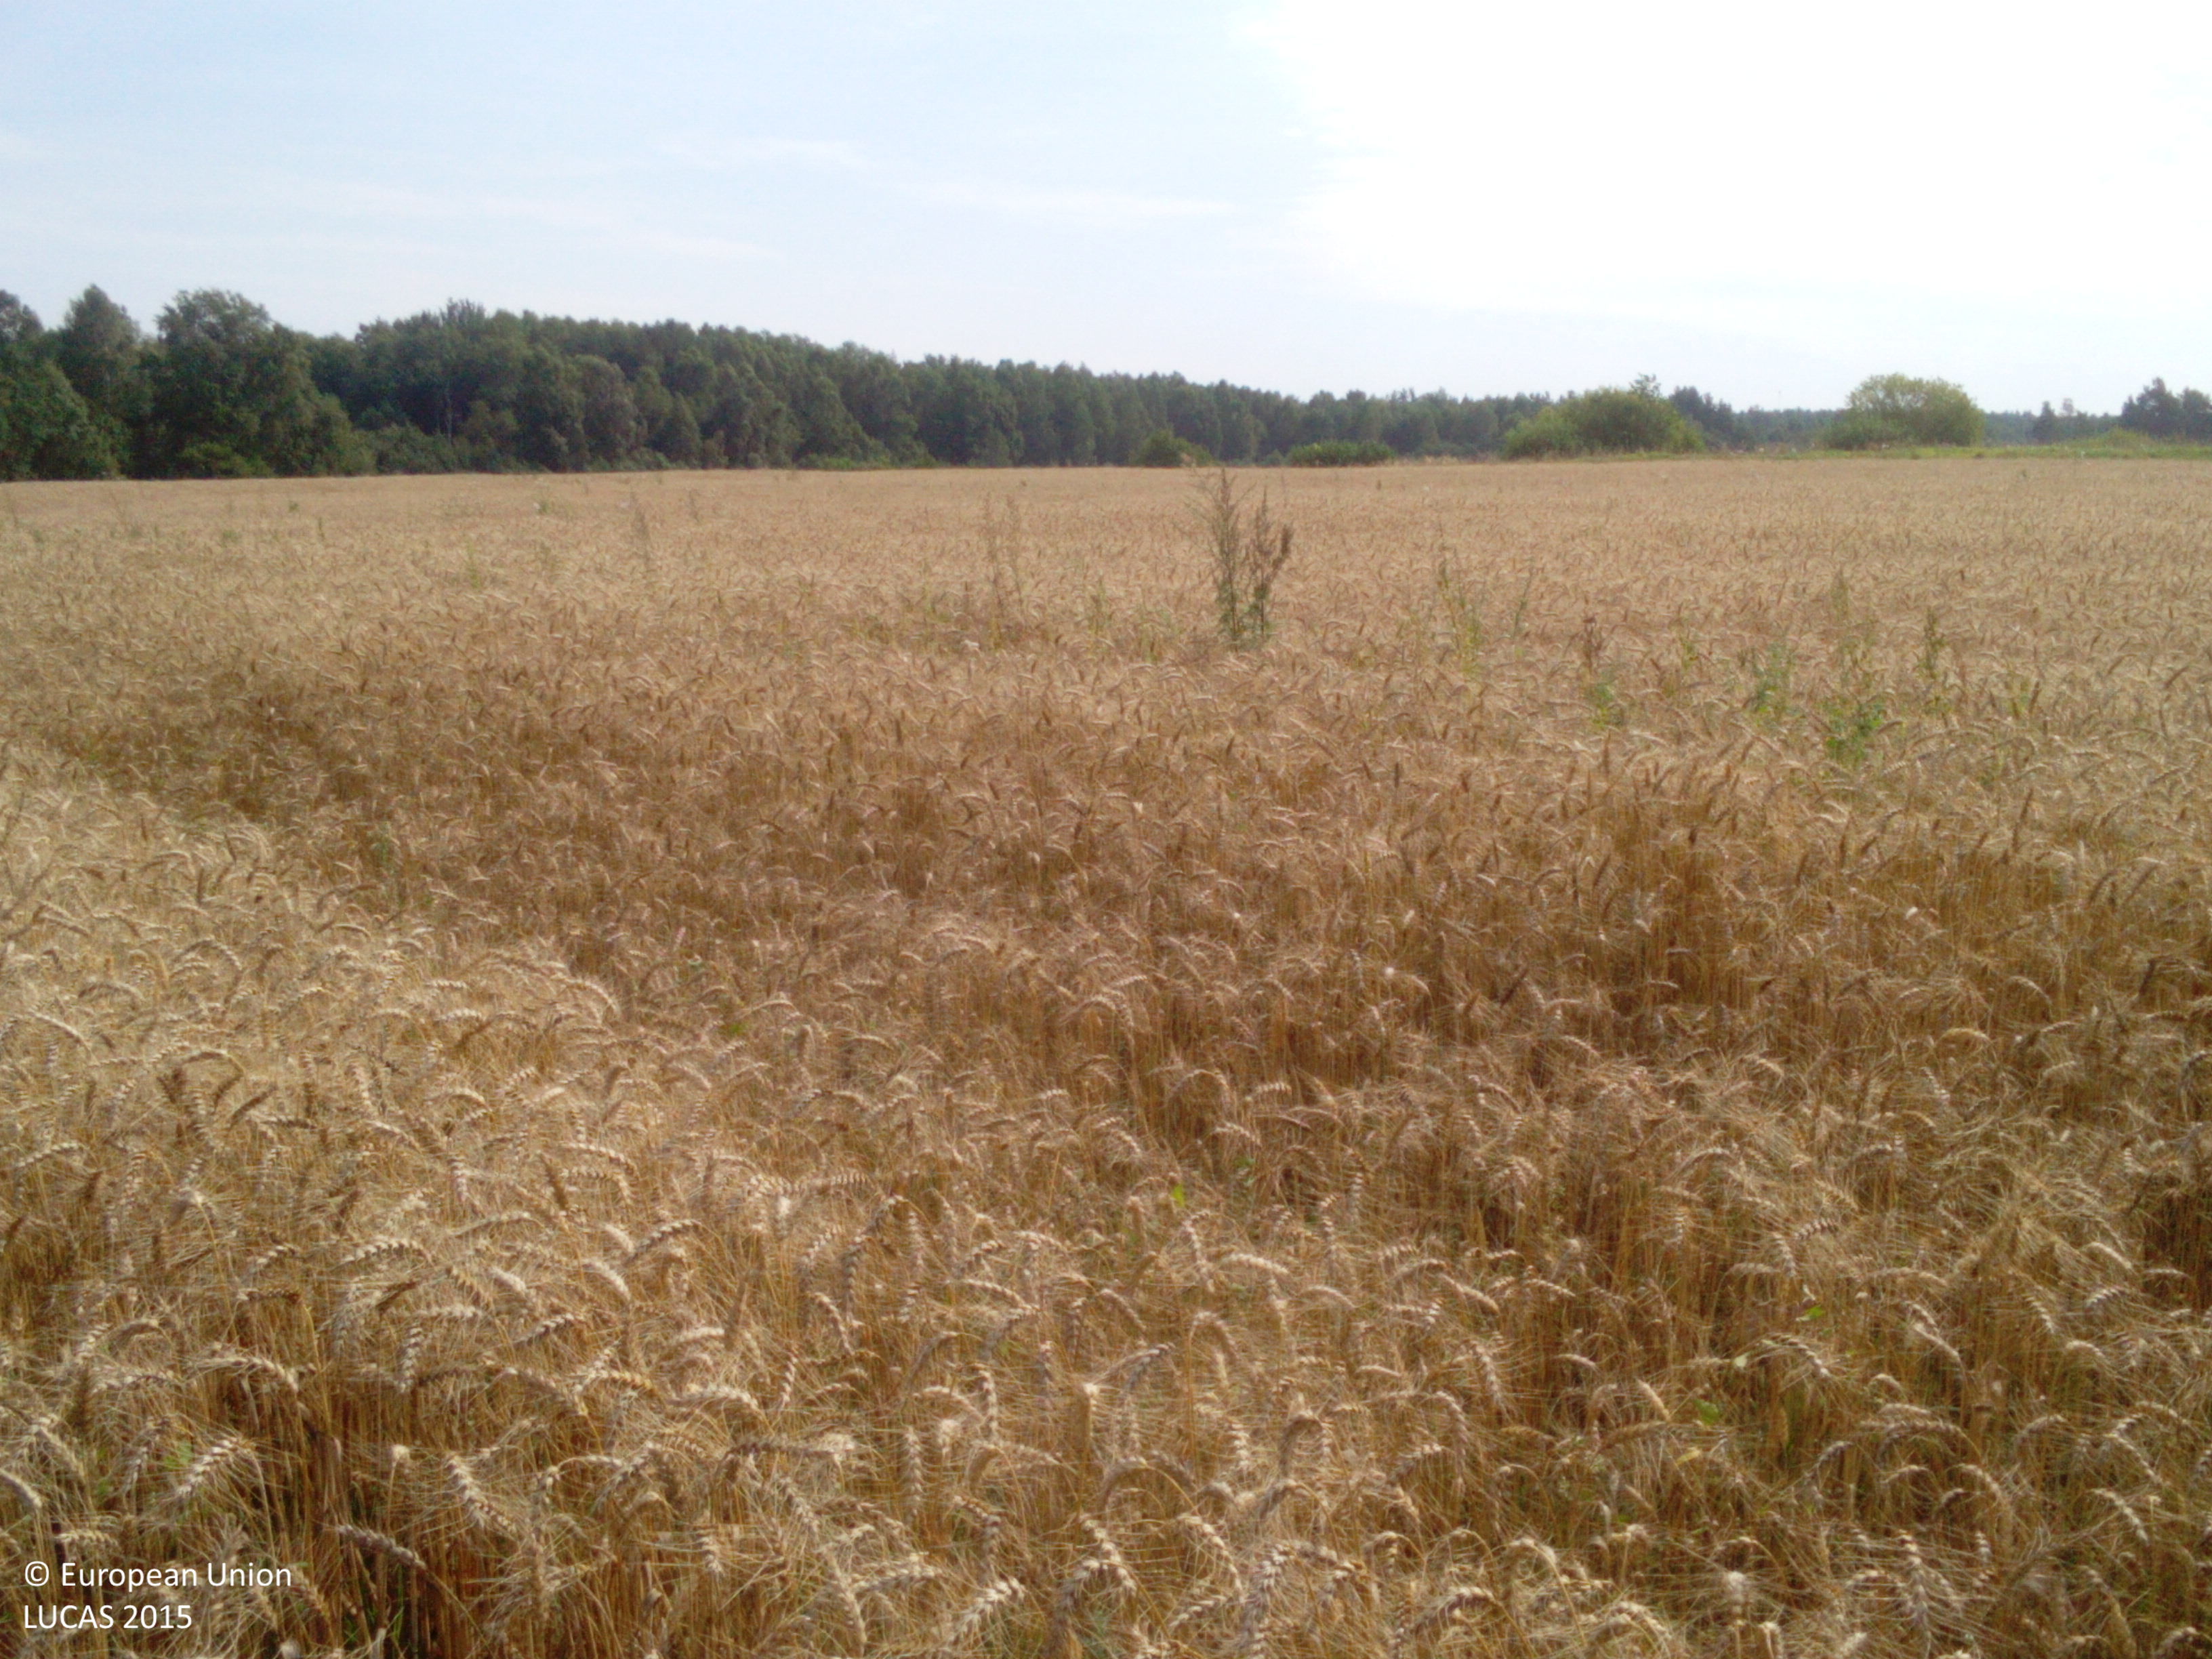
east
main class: Cropland
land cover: Common wheat
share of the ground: > 75 %
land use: Agriculture (excluding fallow land and kitchen gardens)
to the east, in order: Common wheat; Abandoned hedges; Paved roads, cycling and walking lanes; Spontaneously vegetated surfaces; Grassland without tree/shrub cover
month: August
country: LV
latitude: 56.1803
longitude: 21.2690
